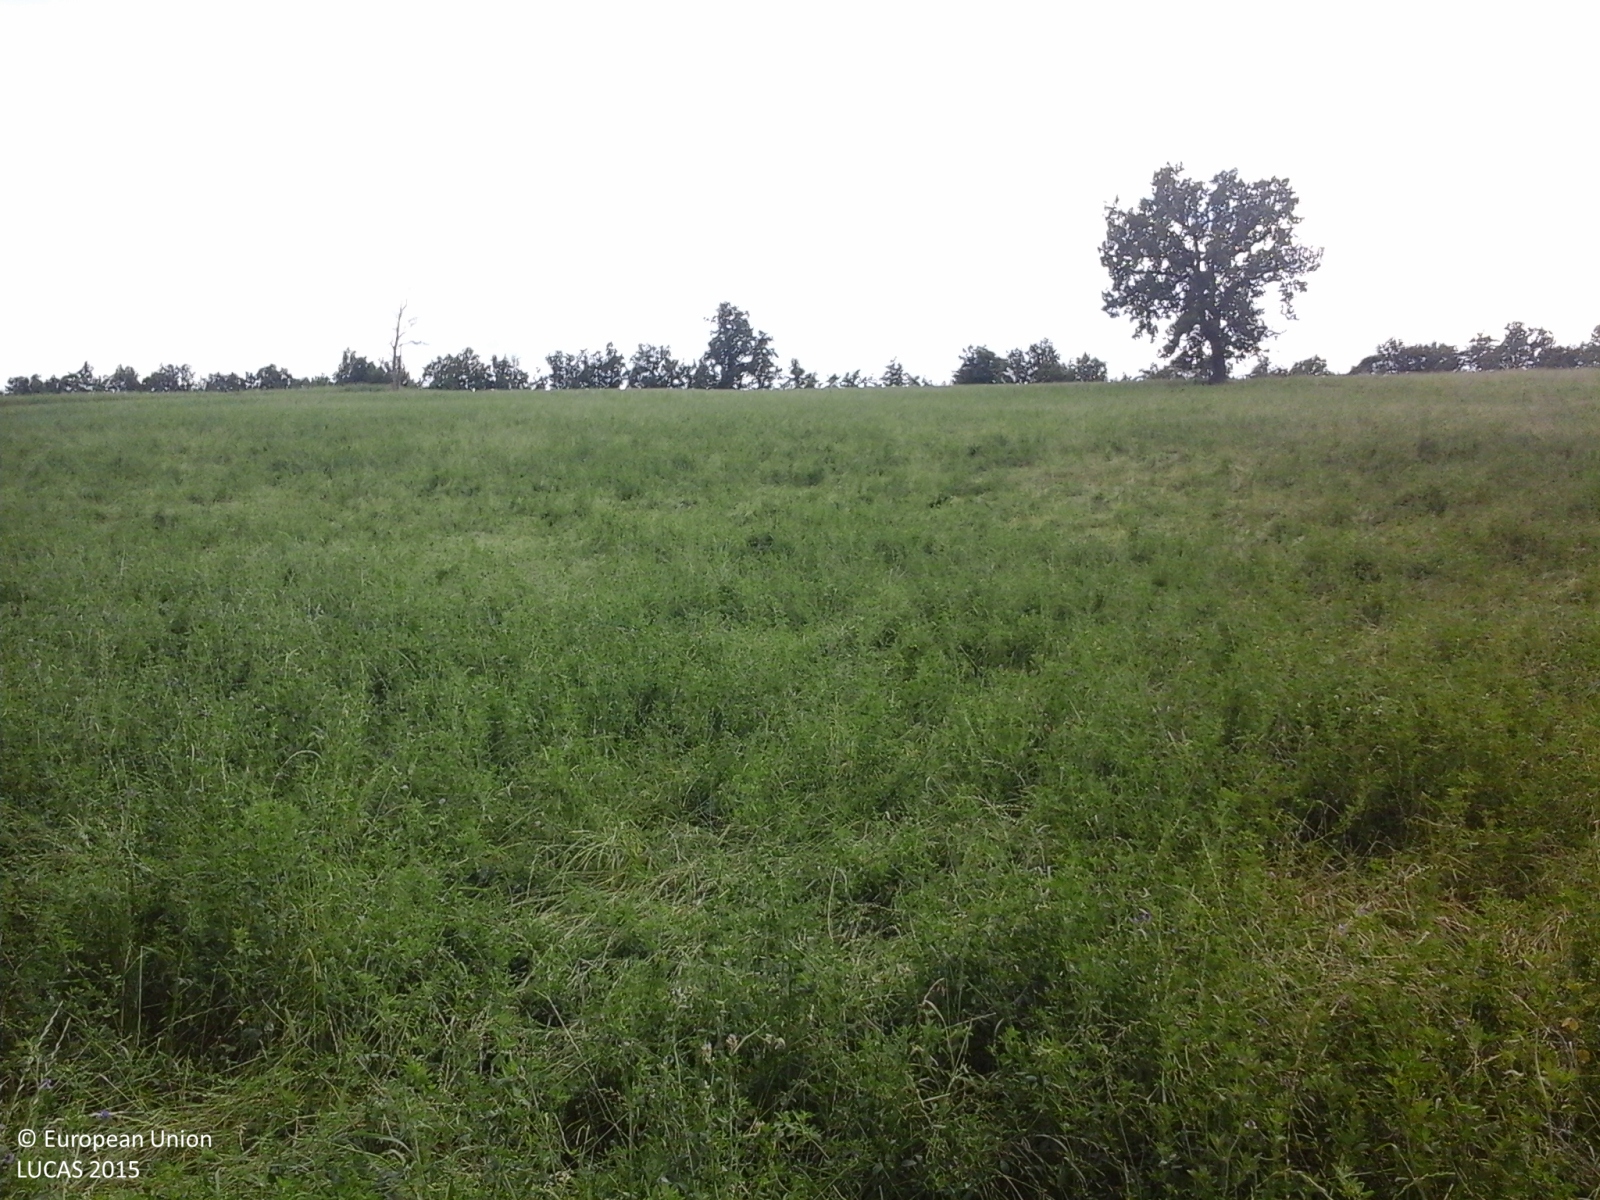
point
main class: Cropland
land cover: Lucerne
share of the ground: > 75 %
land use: Agriculture (excluding fallow land and kitchen gardens)
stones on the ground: < 10 %
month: June
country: IT
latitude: 44.1938
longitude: 11.6103
